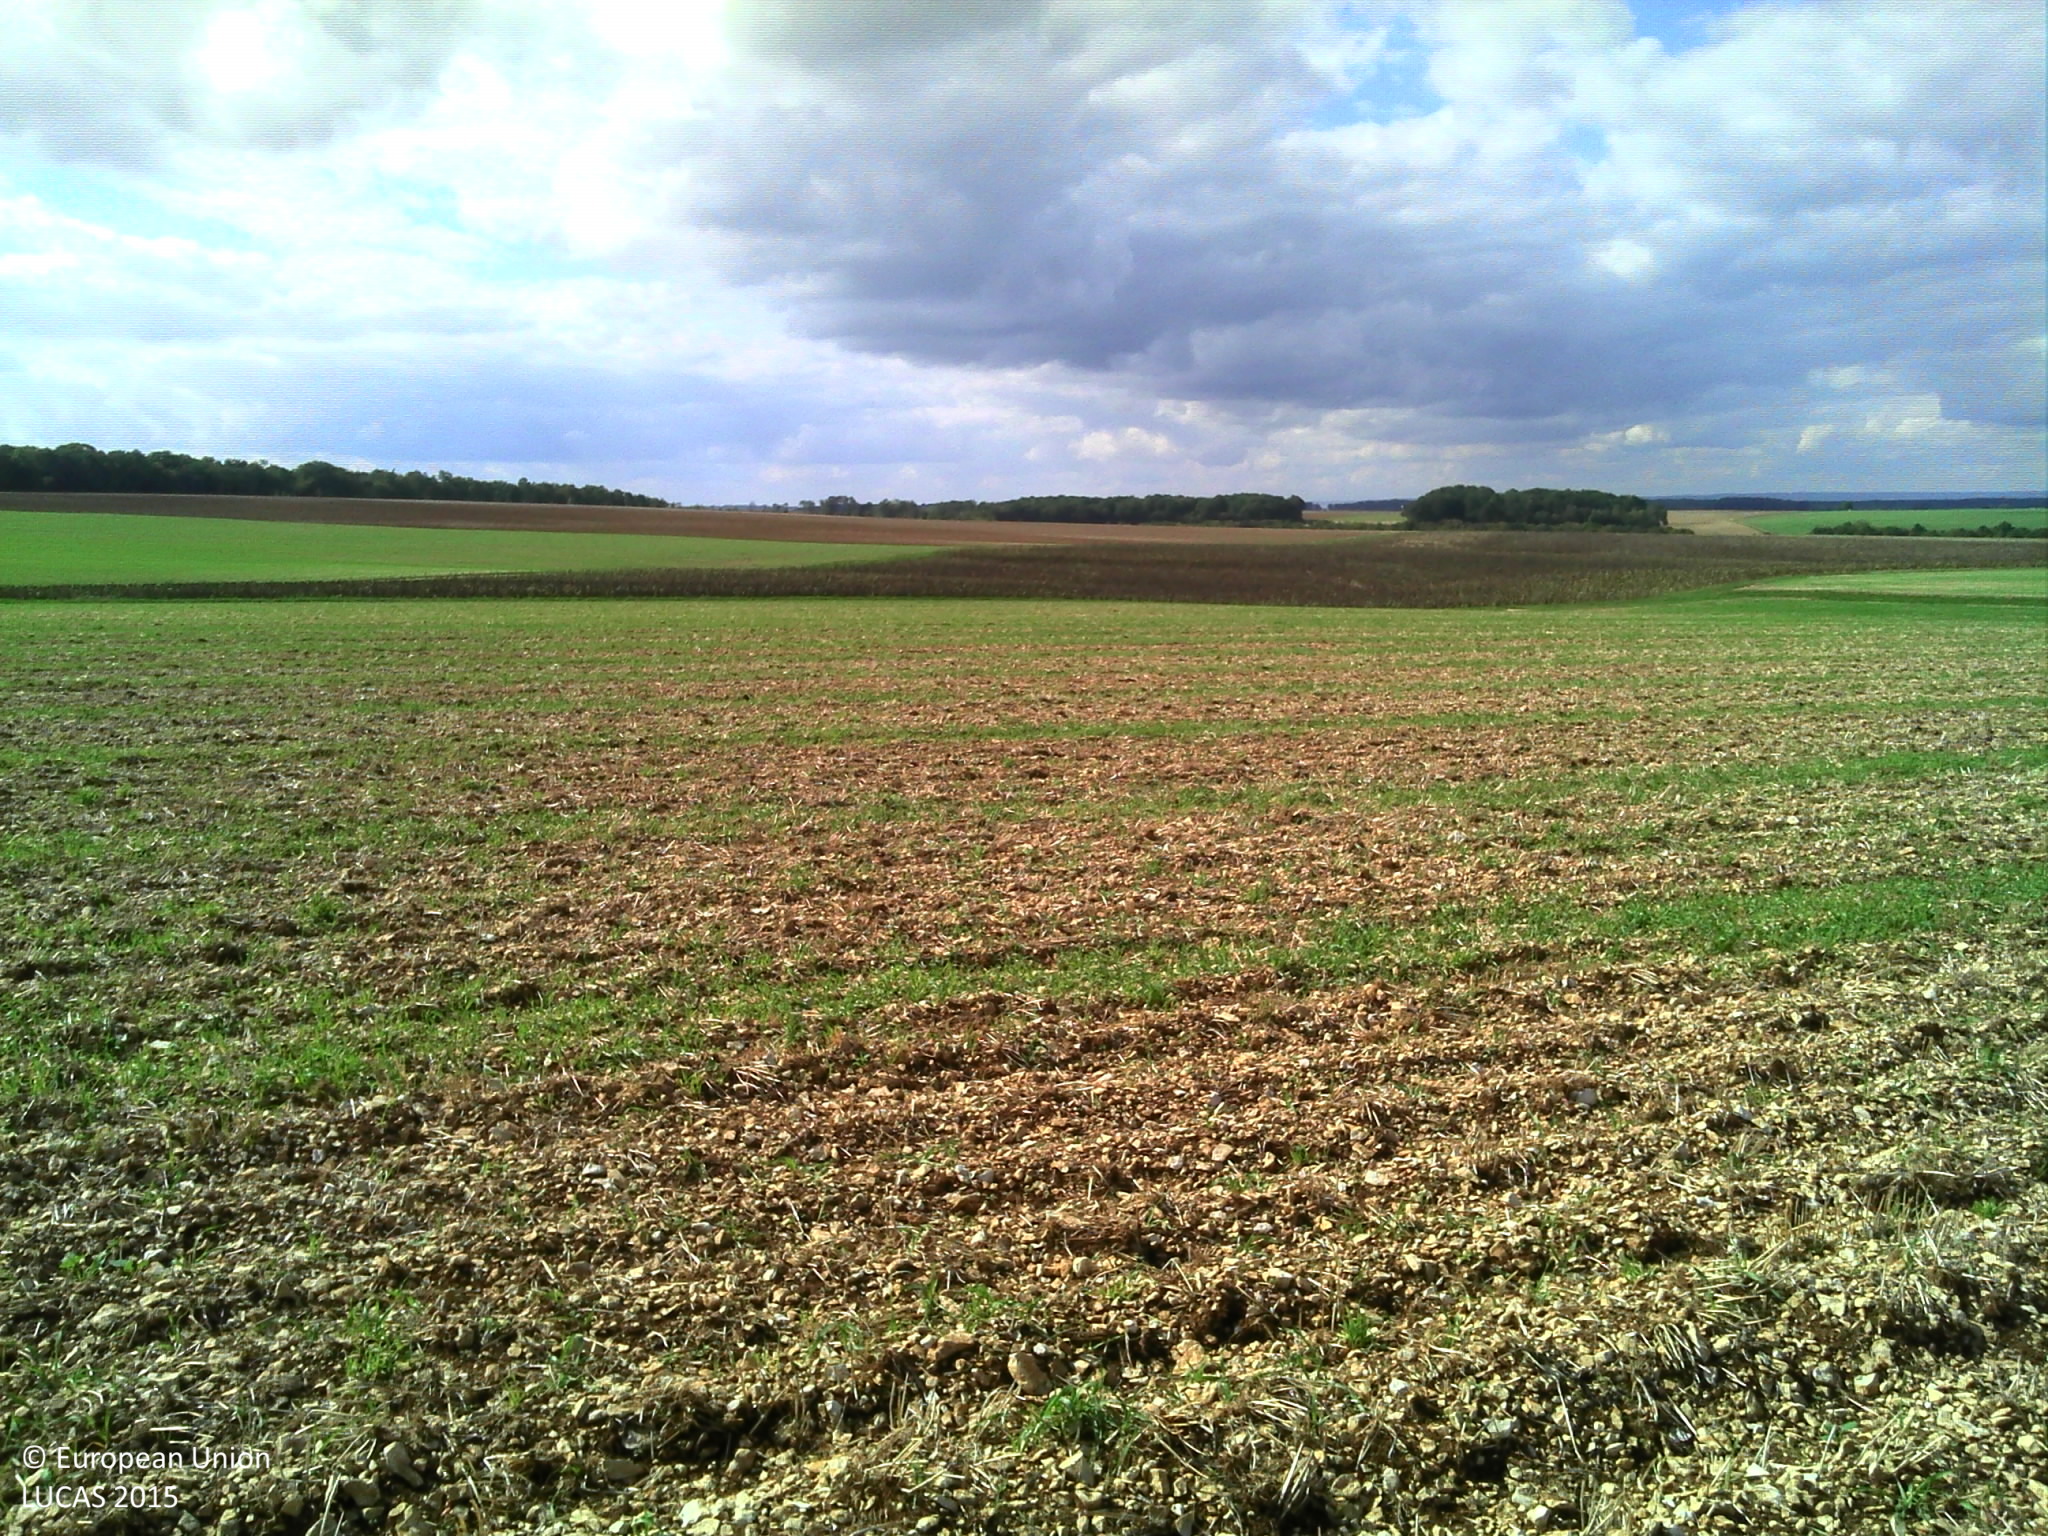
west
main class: Cropland
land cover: Barley
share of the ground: > 75 %
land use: Agriculture (excluding fallow land and kitchen gardens)
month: September
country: FR
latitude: 48.0371
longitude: 4.2435
